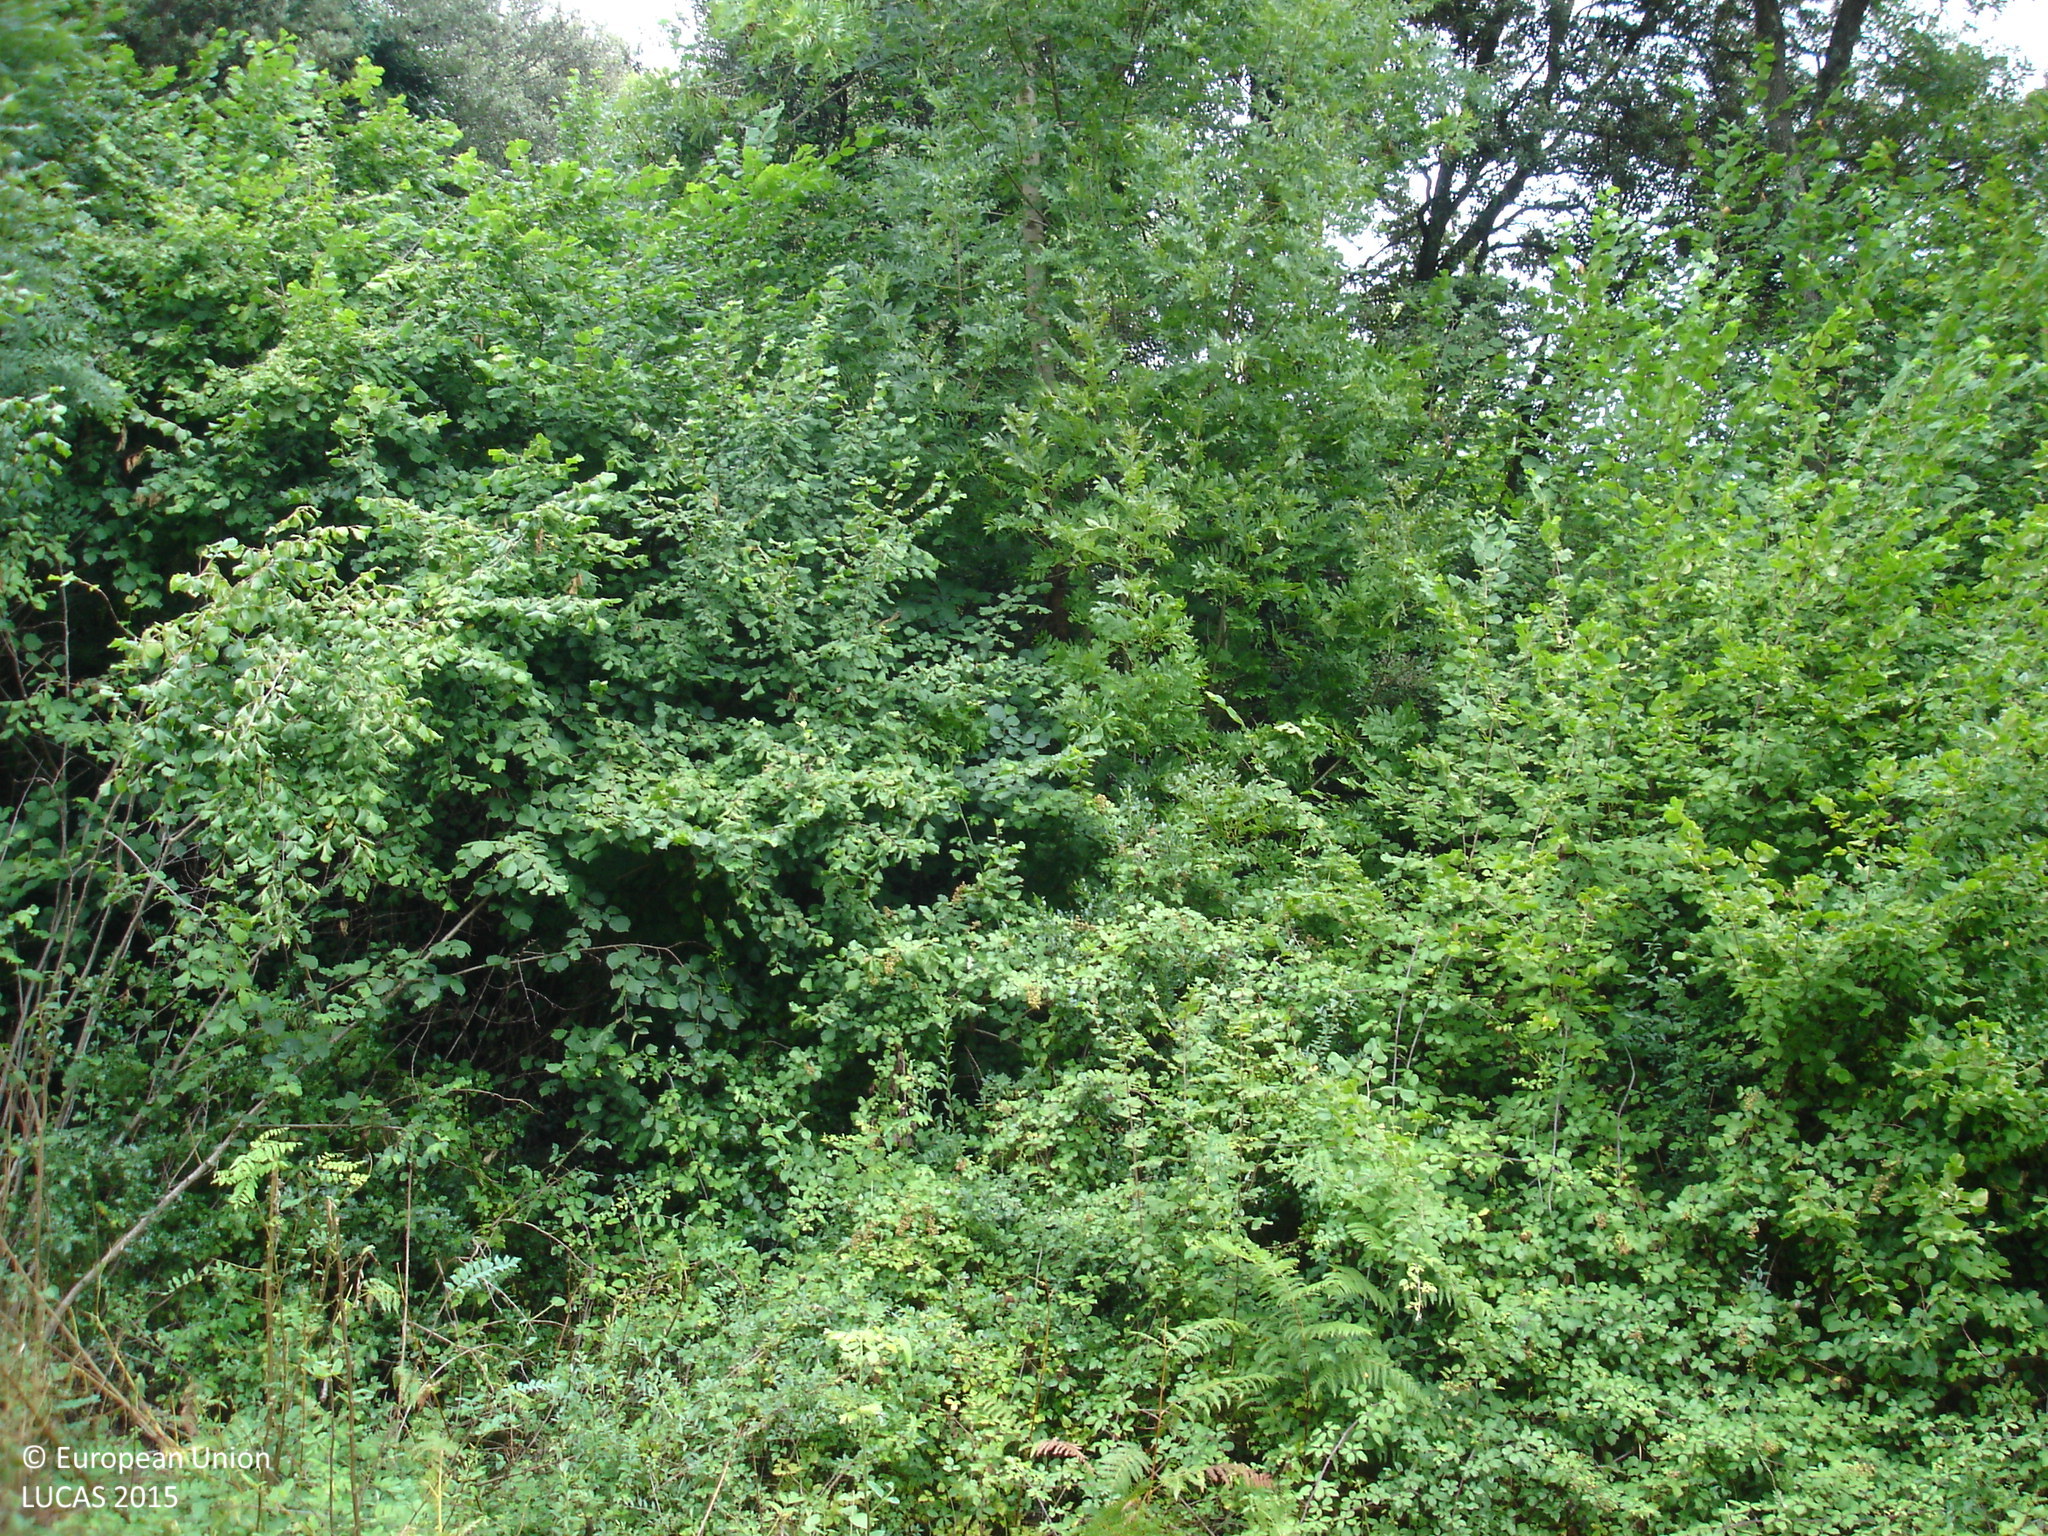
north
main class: Woodland
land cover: Broadleaved woodland
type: thermophilous deciduous forest
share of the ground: > 75 %
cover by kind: broadleaved forest trees 80 %, shrubs 20 %
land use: Forestry
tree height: > 5 m
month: July
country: ES
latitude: 42.1616
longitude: 2.5463
